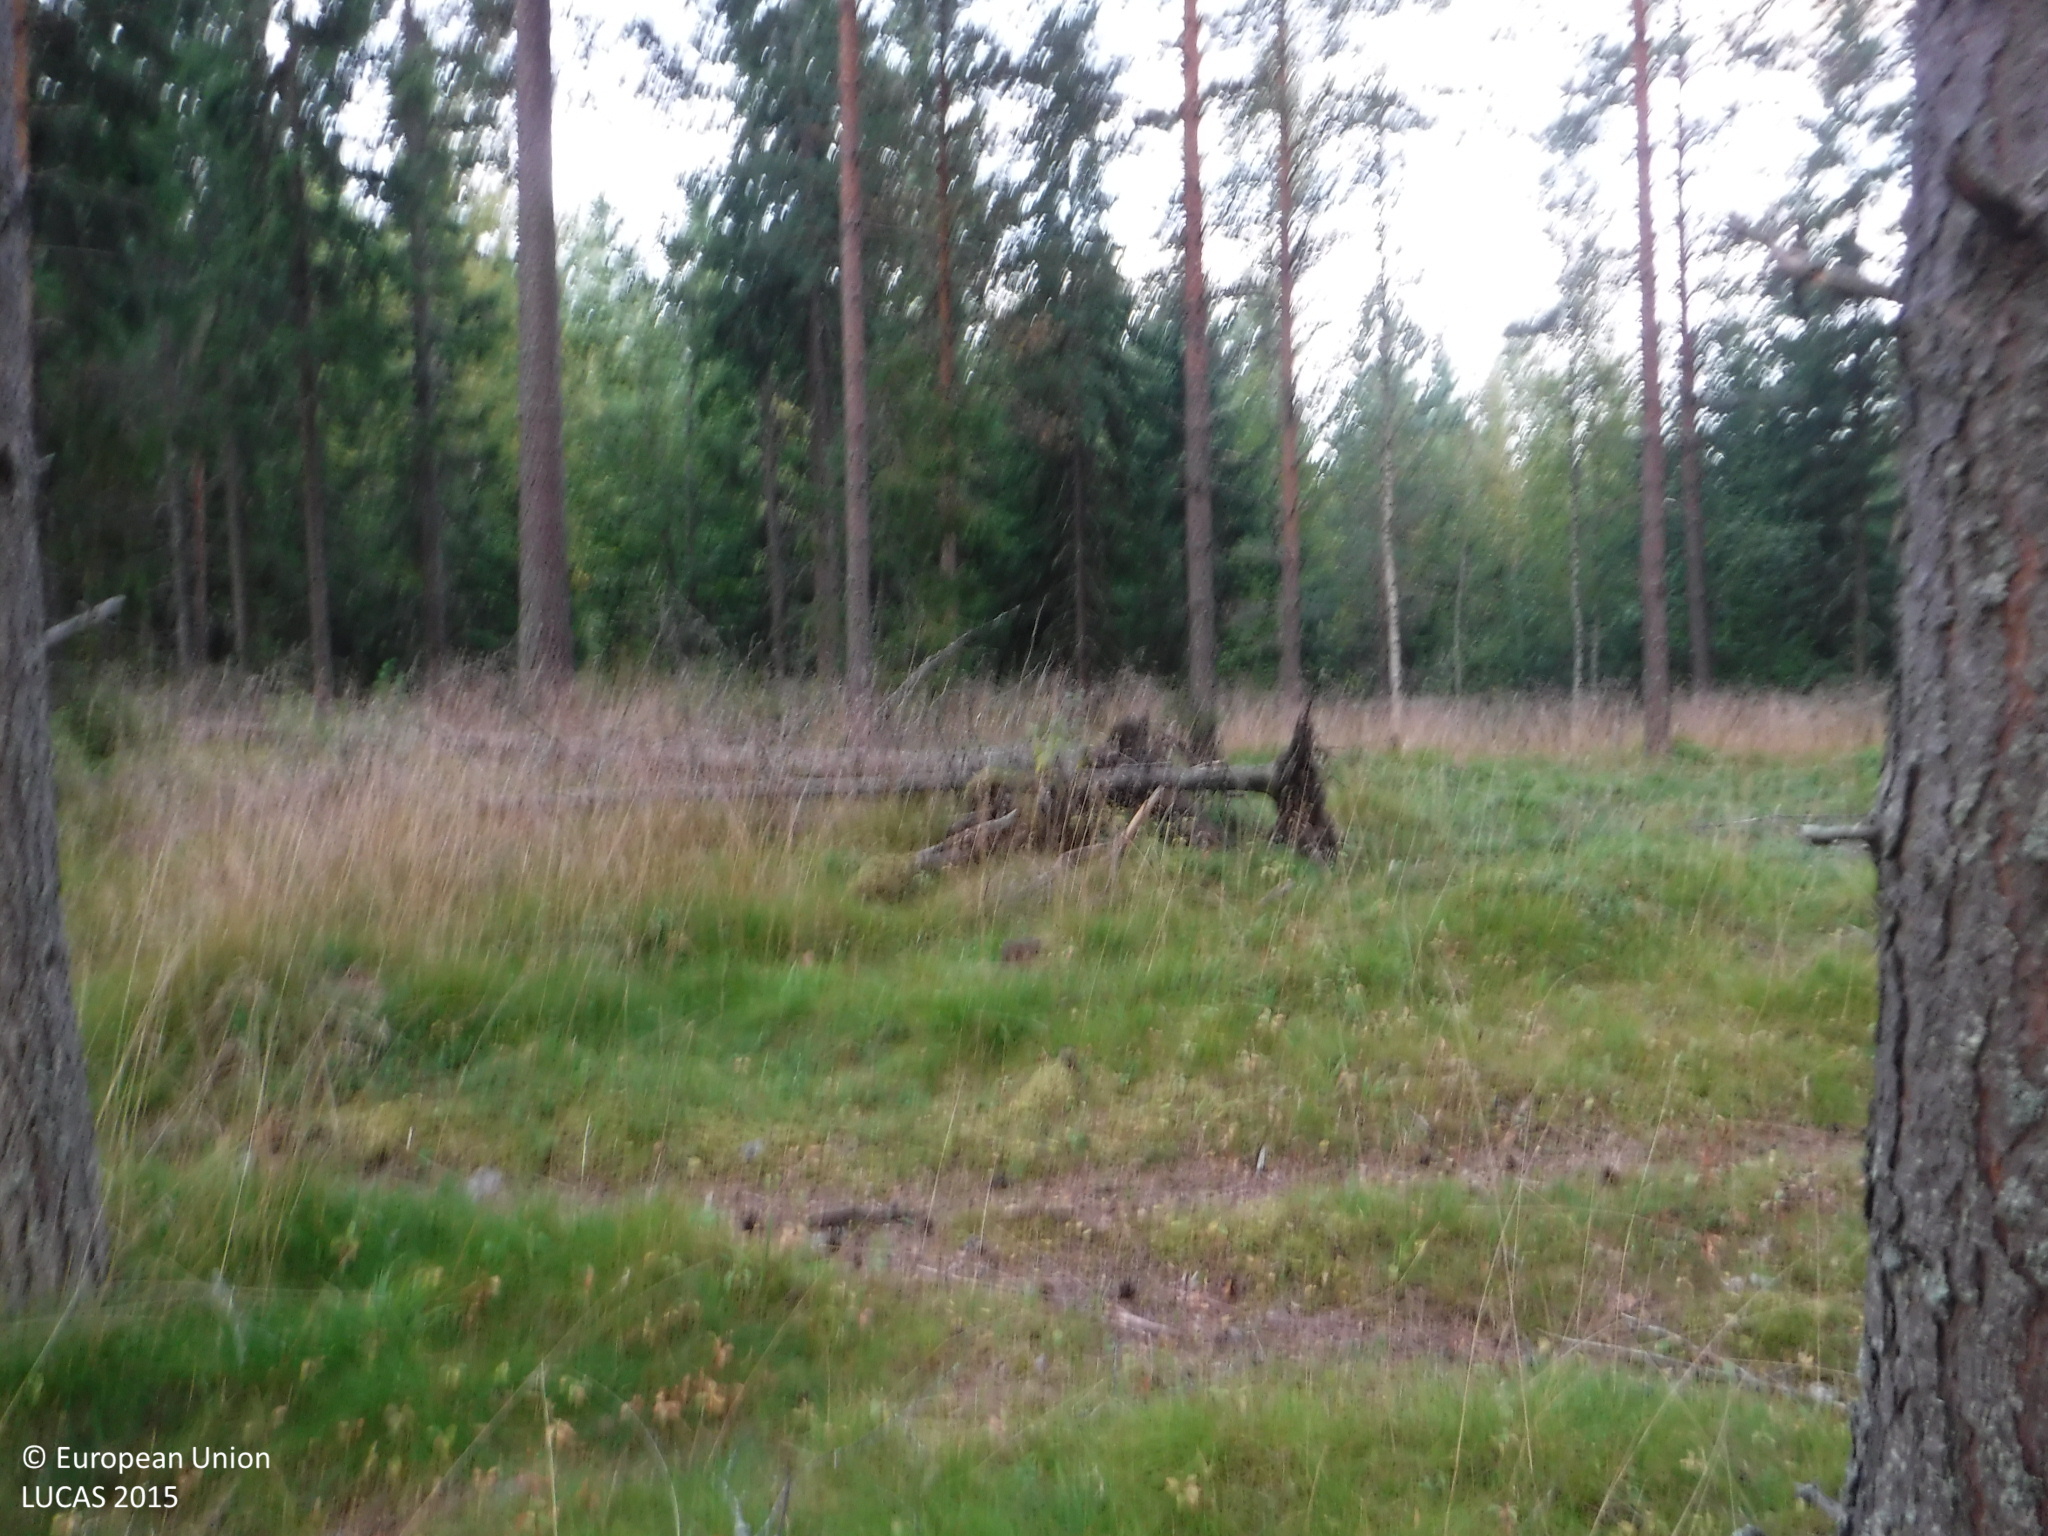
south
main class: Woodland
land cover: Pine dominated coniferous woodland
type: boreal forest
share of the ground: 50 - 75 %
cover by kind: coniferous forest trees 50 %, herbaceous plants 25 %, lichens and mosses 20 %, shrubs 5 %
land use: Forestry
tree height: > 5 m
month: August
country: FI
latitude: 61.1081
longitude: 23.0438
